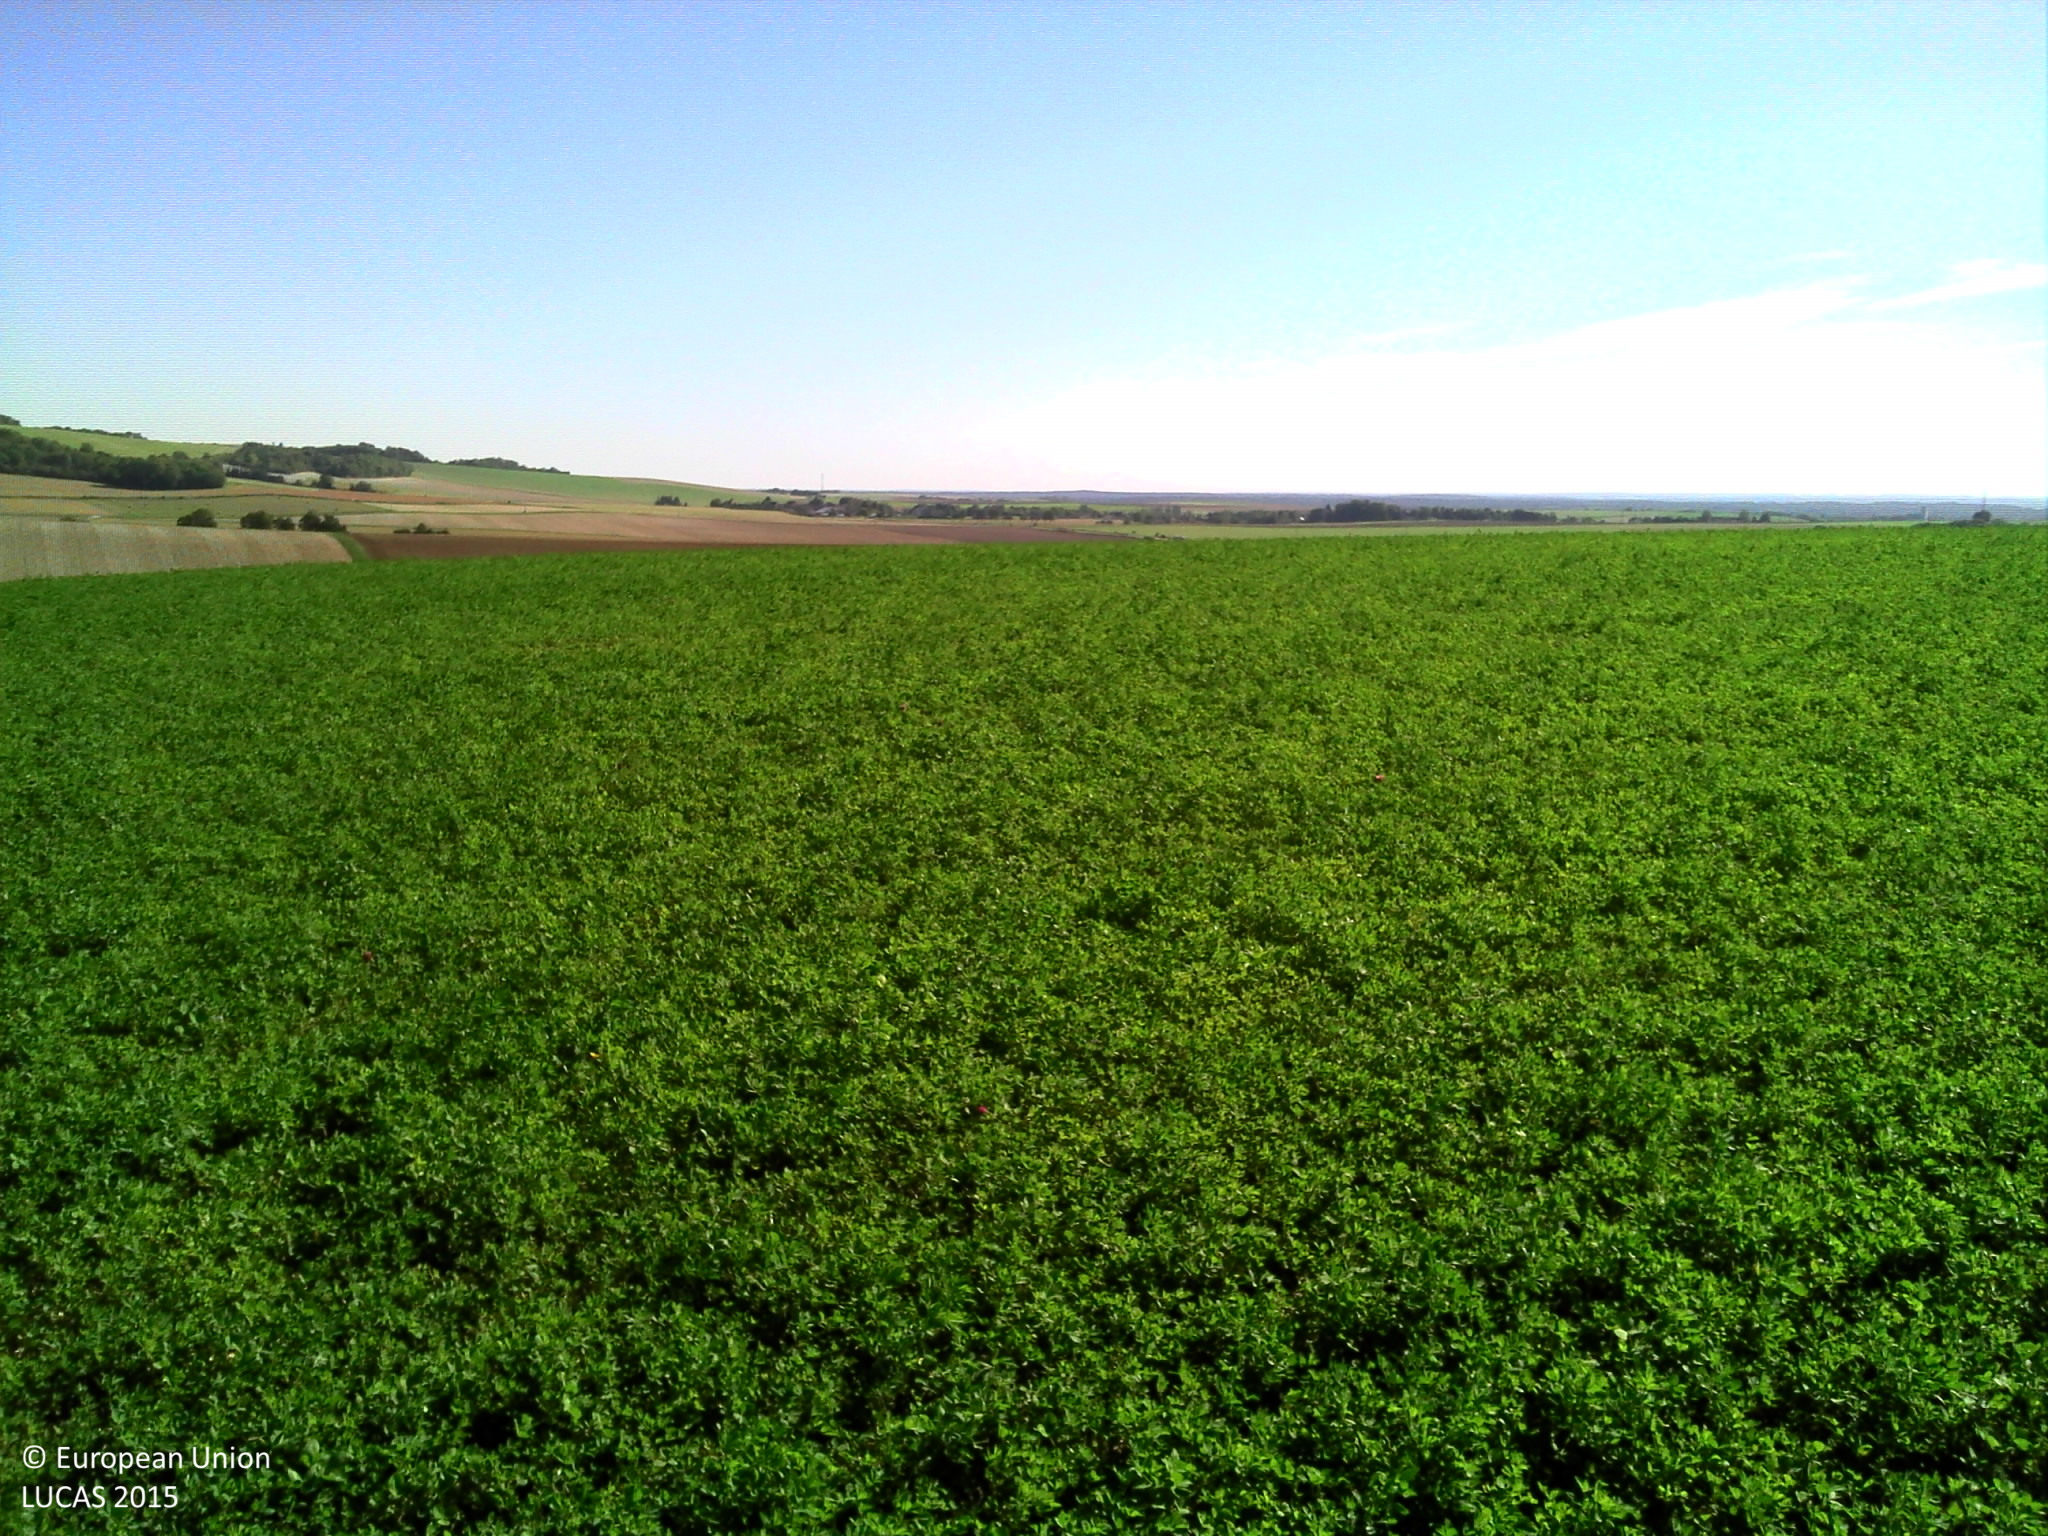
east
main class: Cropland
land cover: Lucerne
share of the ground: > 75 %
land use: Agriculture (excluding fallow land and kitchen gardens)
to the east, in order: Lucerne; Grassland without tree/shrub cover; Barley
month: September
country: FR
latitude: 48.1079
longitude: 3.8852
